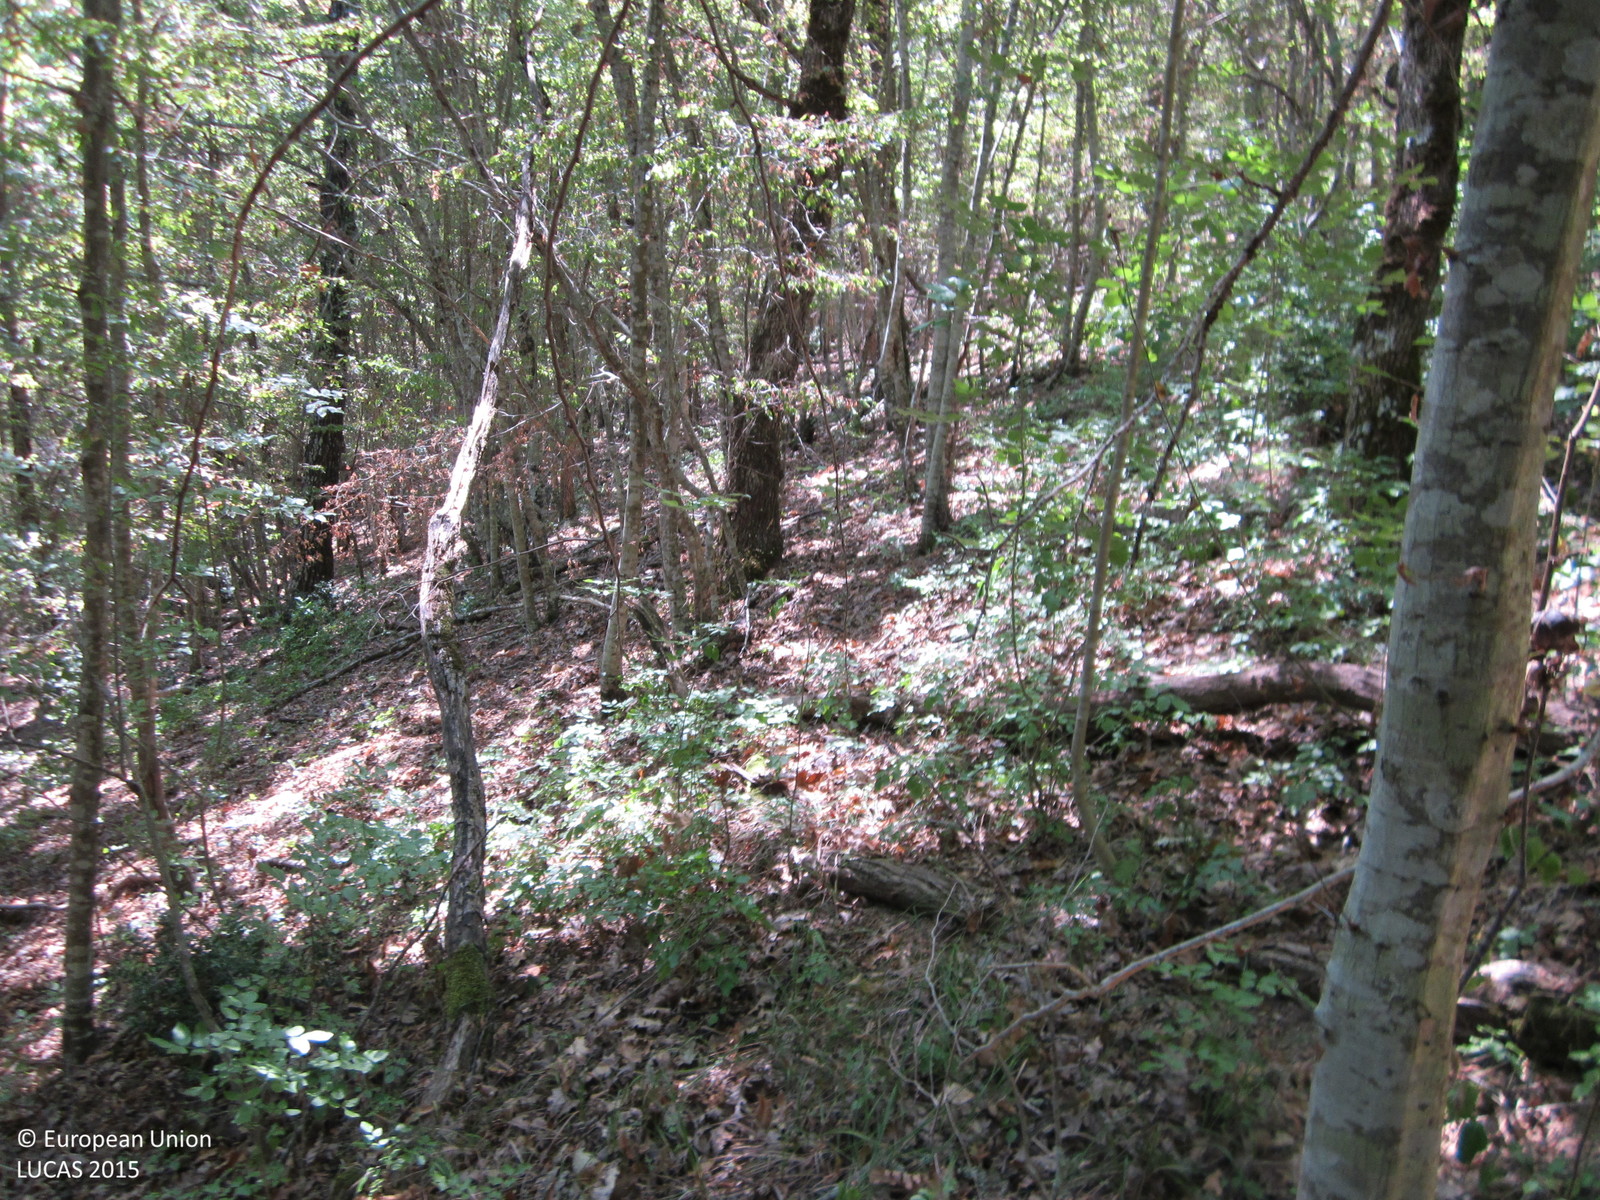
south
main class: Woodland
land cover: Broadleaved woodland
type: thermophilous deciduous forest
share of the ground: > 75 %
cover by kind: broadleaved forest trees 90 %, herbaceous plants 5 %, unconsolidated bare surface 5 %
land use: Forestry
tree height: > 5 m
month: August
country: BG
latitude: 42.0588
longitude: 27.7985
